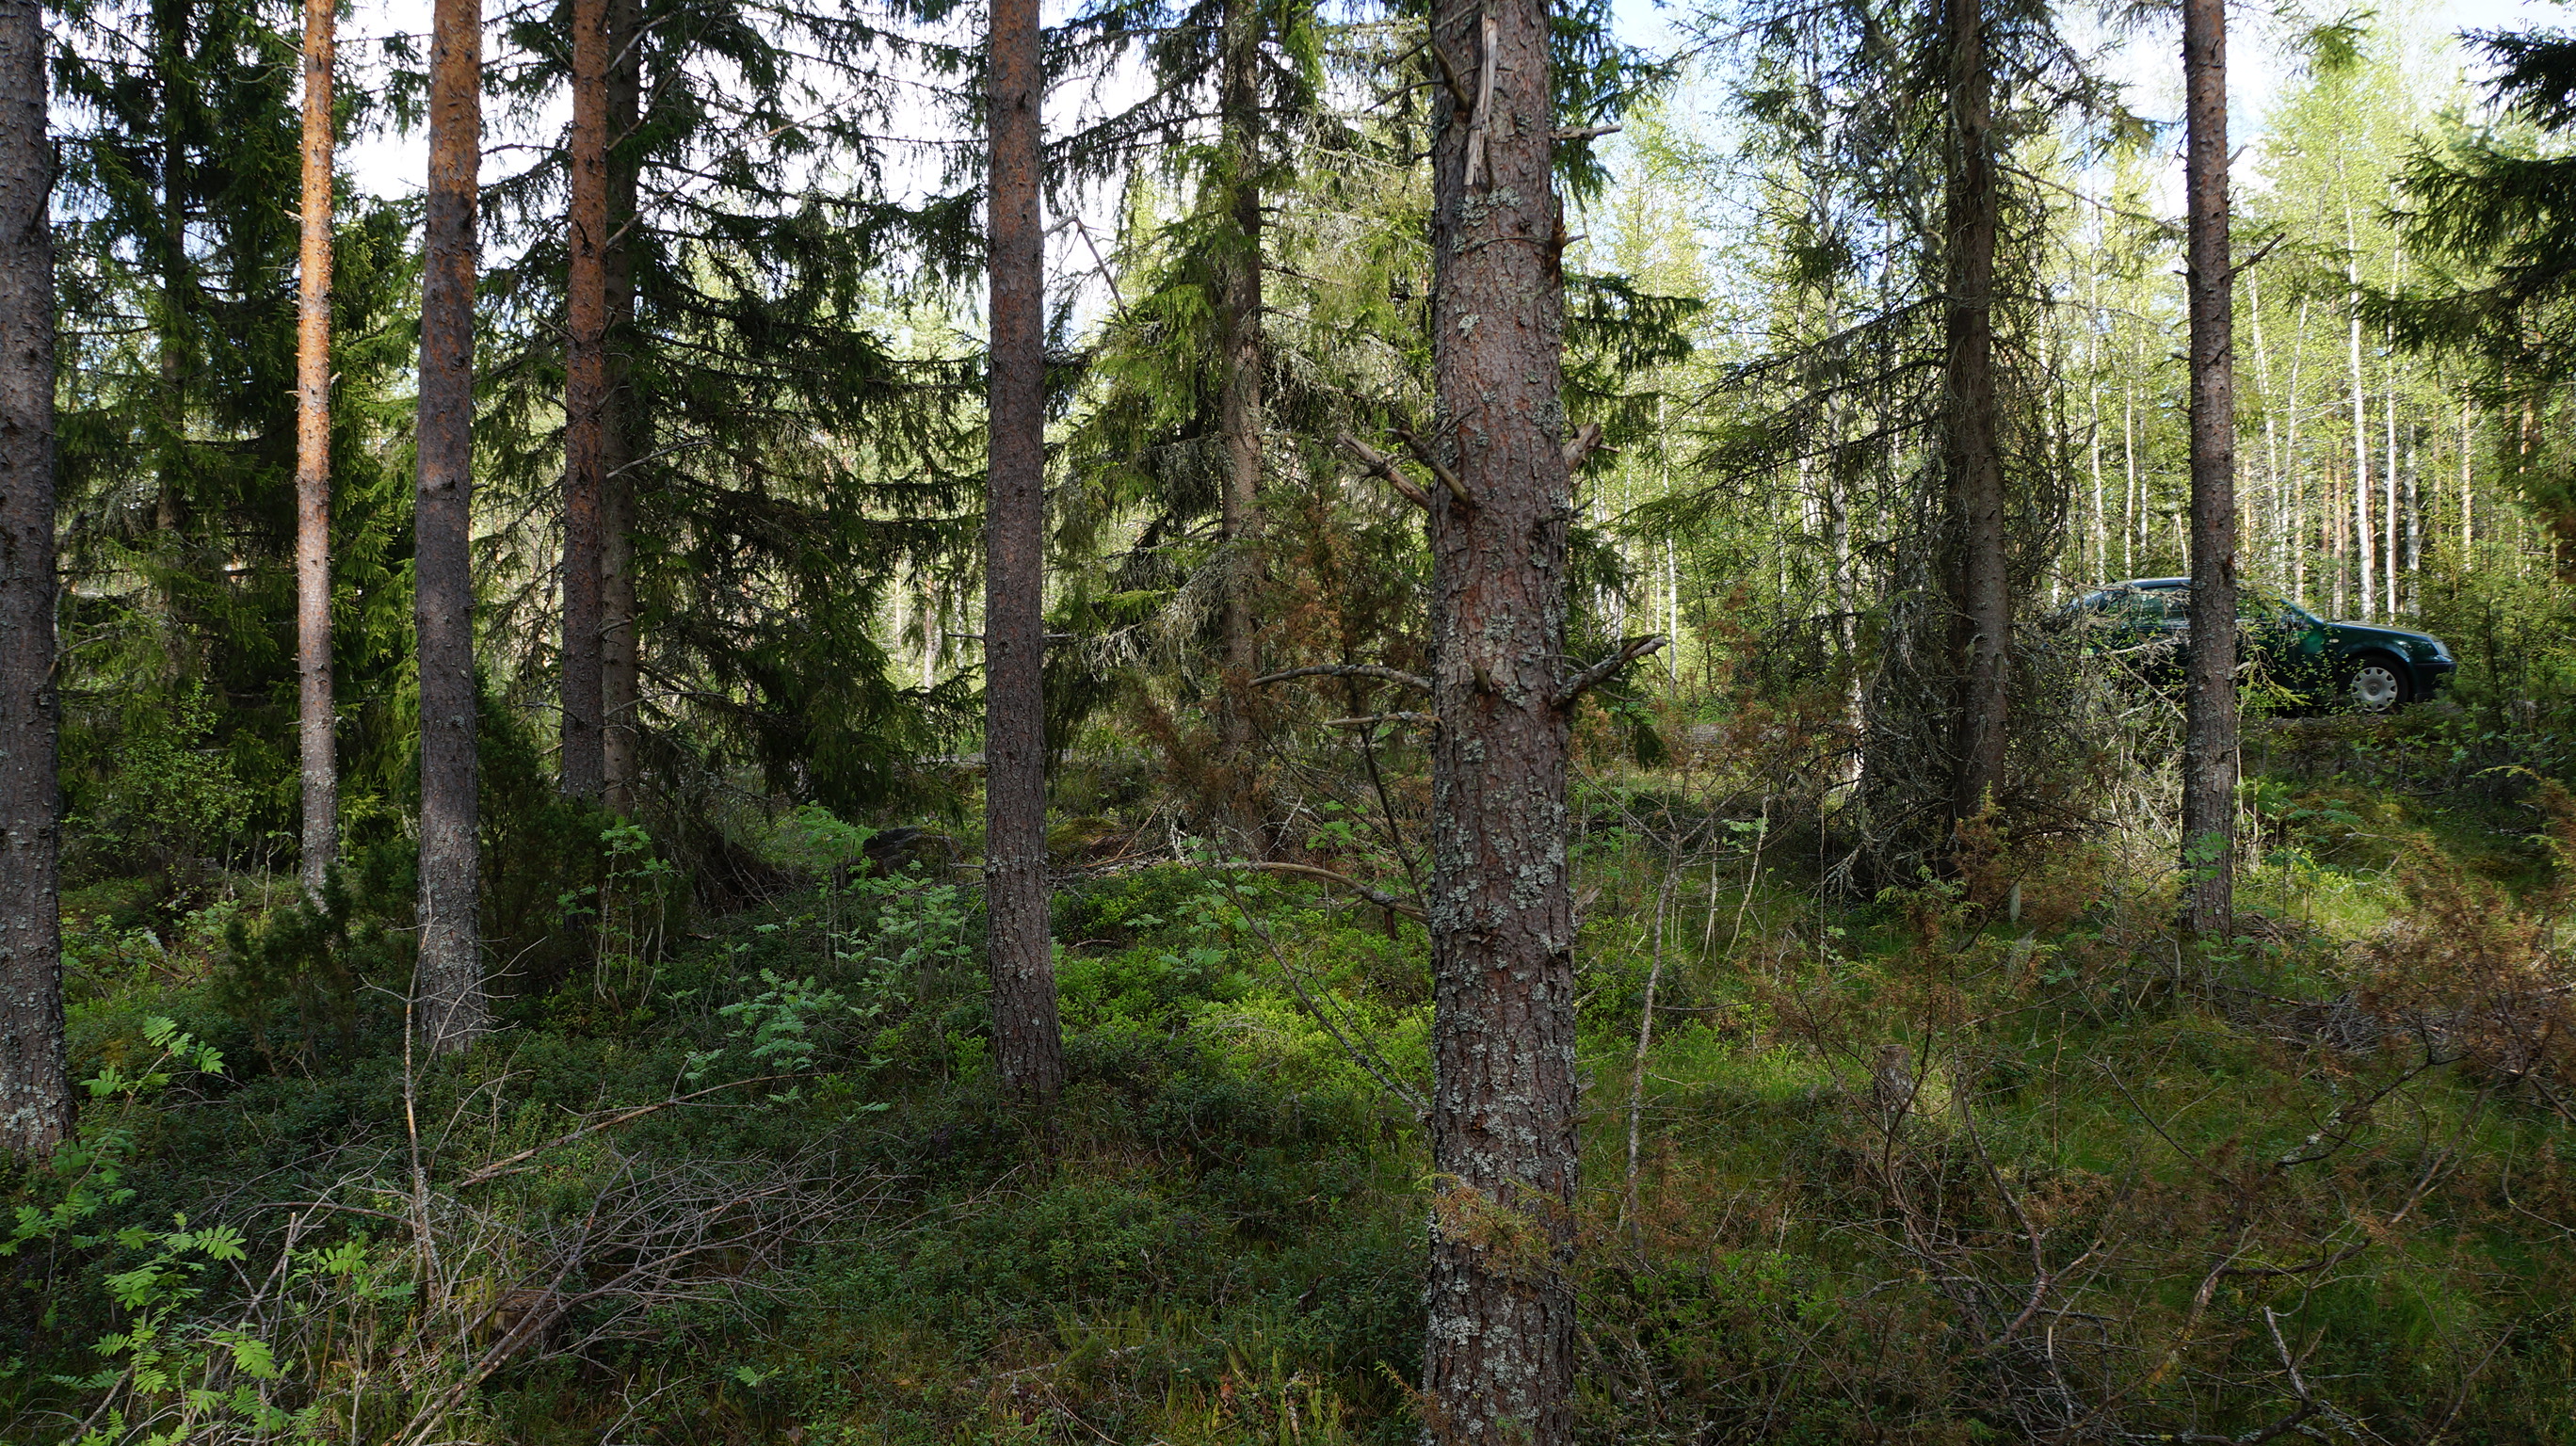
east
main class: Woodland
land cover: Pine dominated mixed woodland
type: boreal forest
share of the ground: > 75 %
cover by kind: coniferous forest trees 60 %, broadleaved forest trees 30 %, shrubs 10 %
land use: Forestry
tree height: > 5 m
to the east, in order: Pine dominated mixed woodland; Paved roads, cycling and walking lanes; Shrubland with sparse tree cover; Ditches and canals; Pine dominated mixed woodland; Other mixed woodland; Pine dominated mixed woodland; Ditches and canals; Pine dominated mixed woodland; Pine dominated coniferous woodland; Ditches and canals; Pine dominated coniferous woodland; Pine dominated mixed woodland
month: May
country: FI
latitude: 63.7099
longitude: 23.4762
